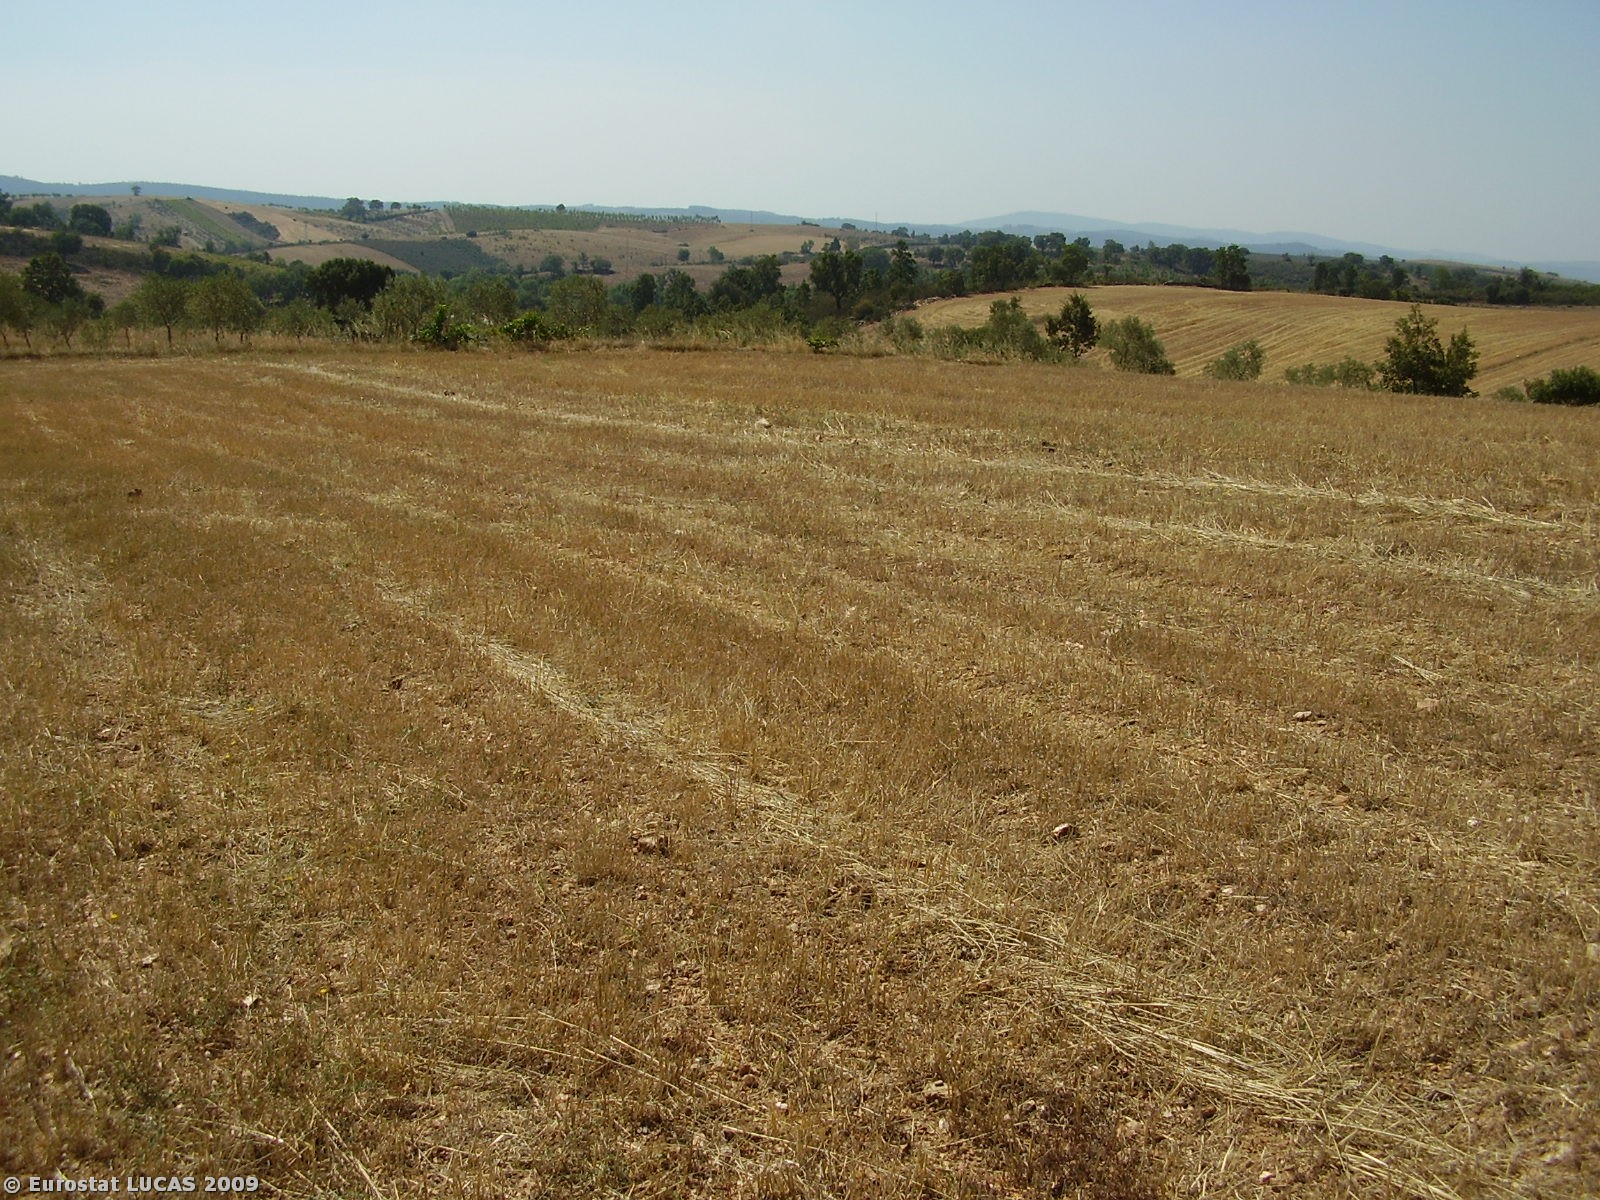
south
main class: Cropland
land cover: Common wheat
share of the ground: < 10 %
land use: Agriculture (excluding fallow land and kitchen gardens)
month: August
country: PT
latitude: 41.3079
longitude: -6.7194
